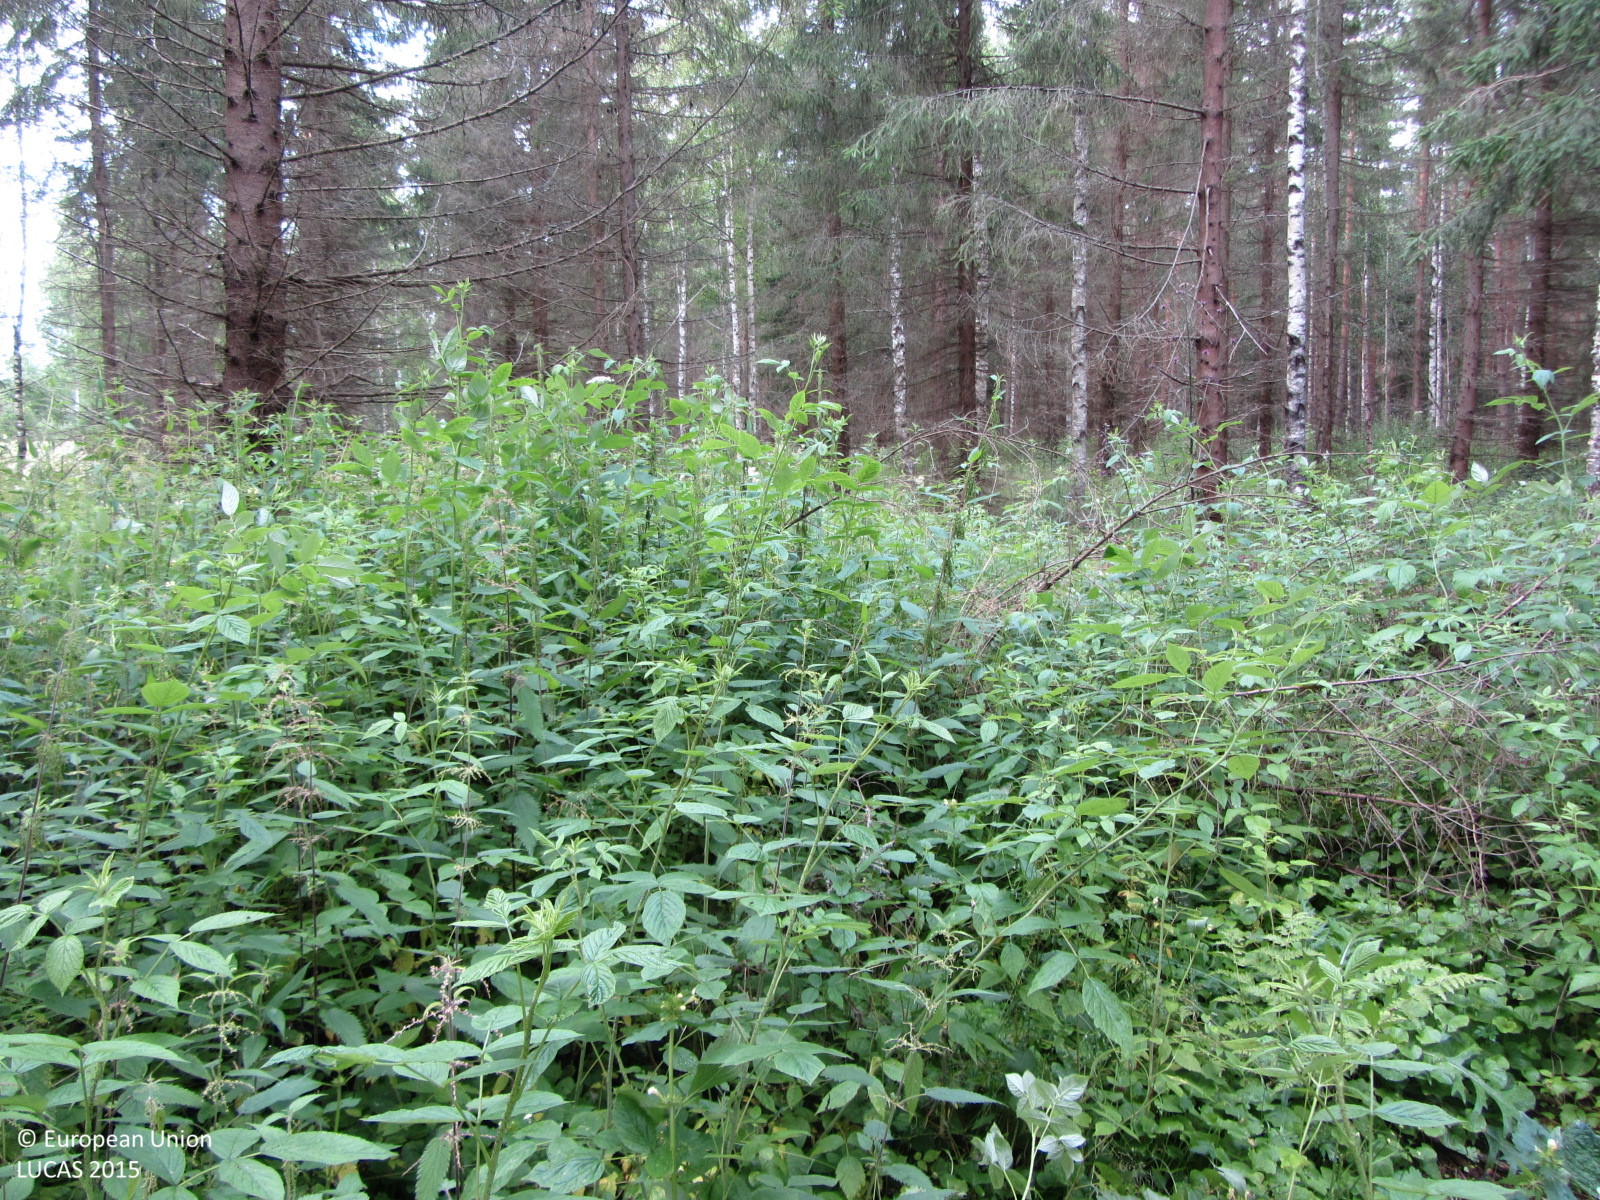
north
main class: Woodland
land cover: Spruce dominated mixed woodland
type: boreal forest
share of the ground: 25 - 50 %
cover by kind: herbaceous plants 55 %, coniferous forest trees 30 %, broadleaved forest trees 15 %
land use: Forestry
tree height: > 5 m
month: July
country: FI
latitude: 60.7033
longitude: 24.7481
